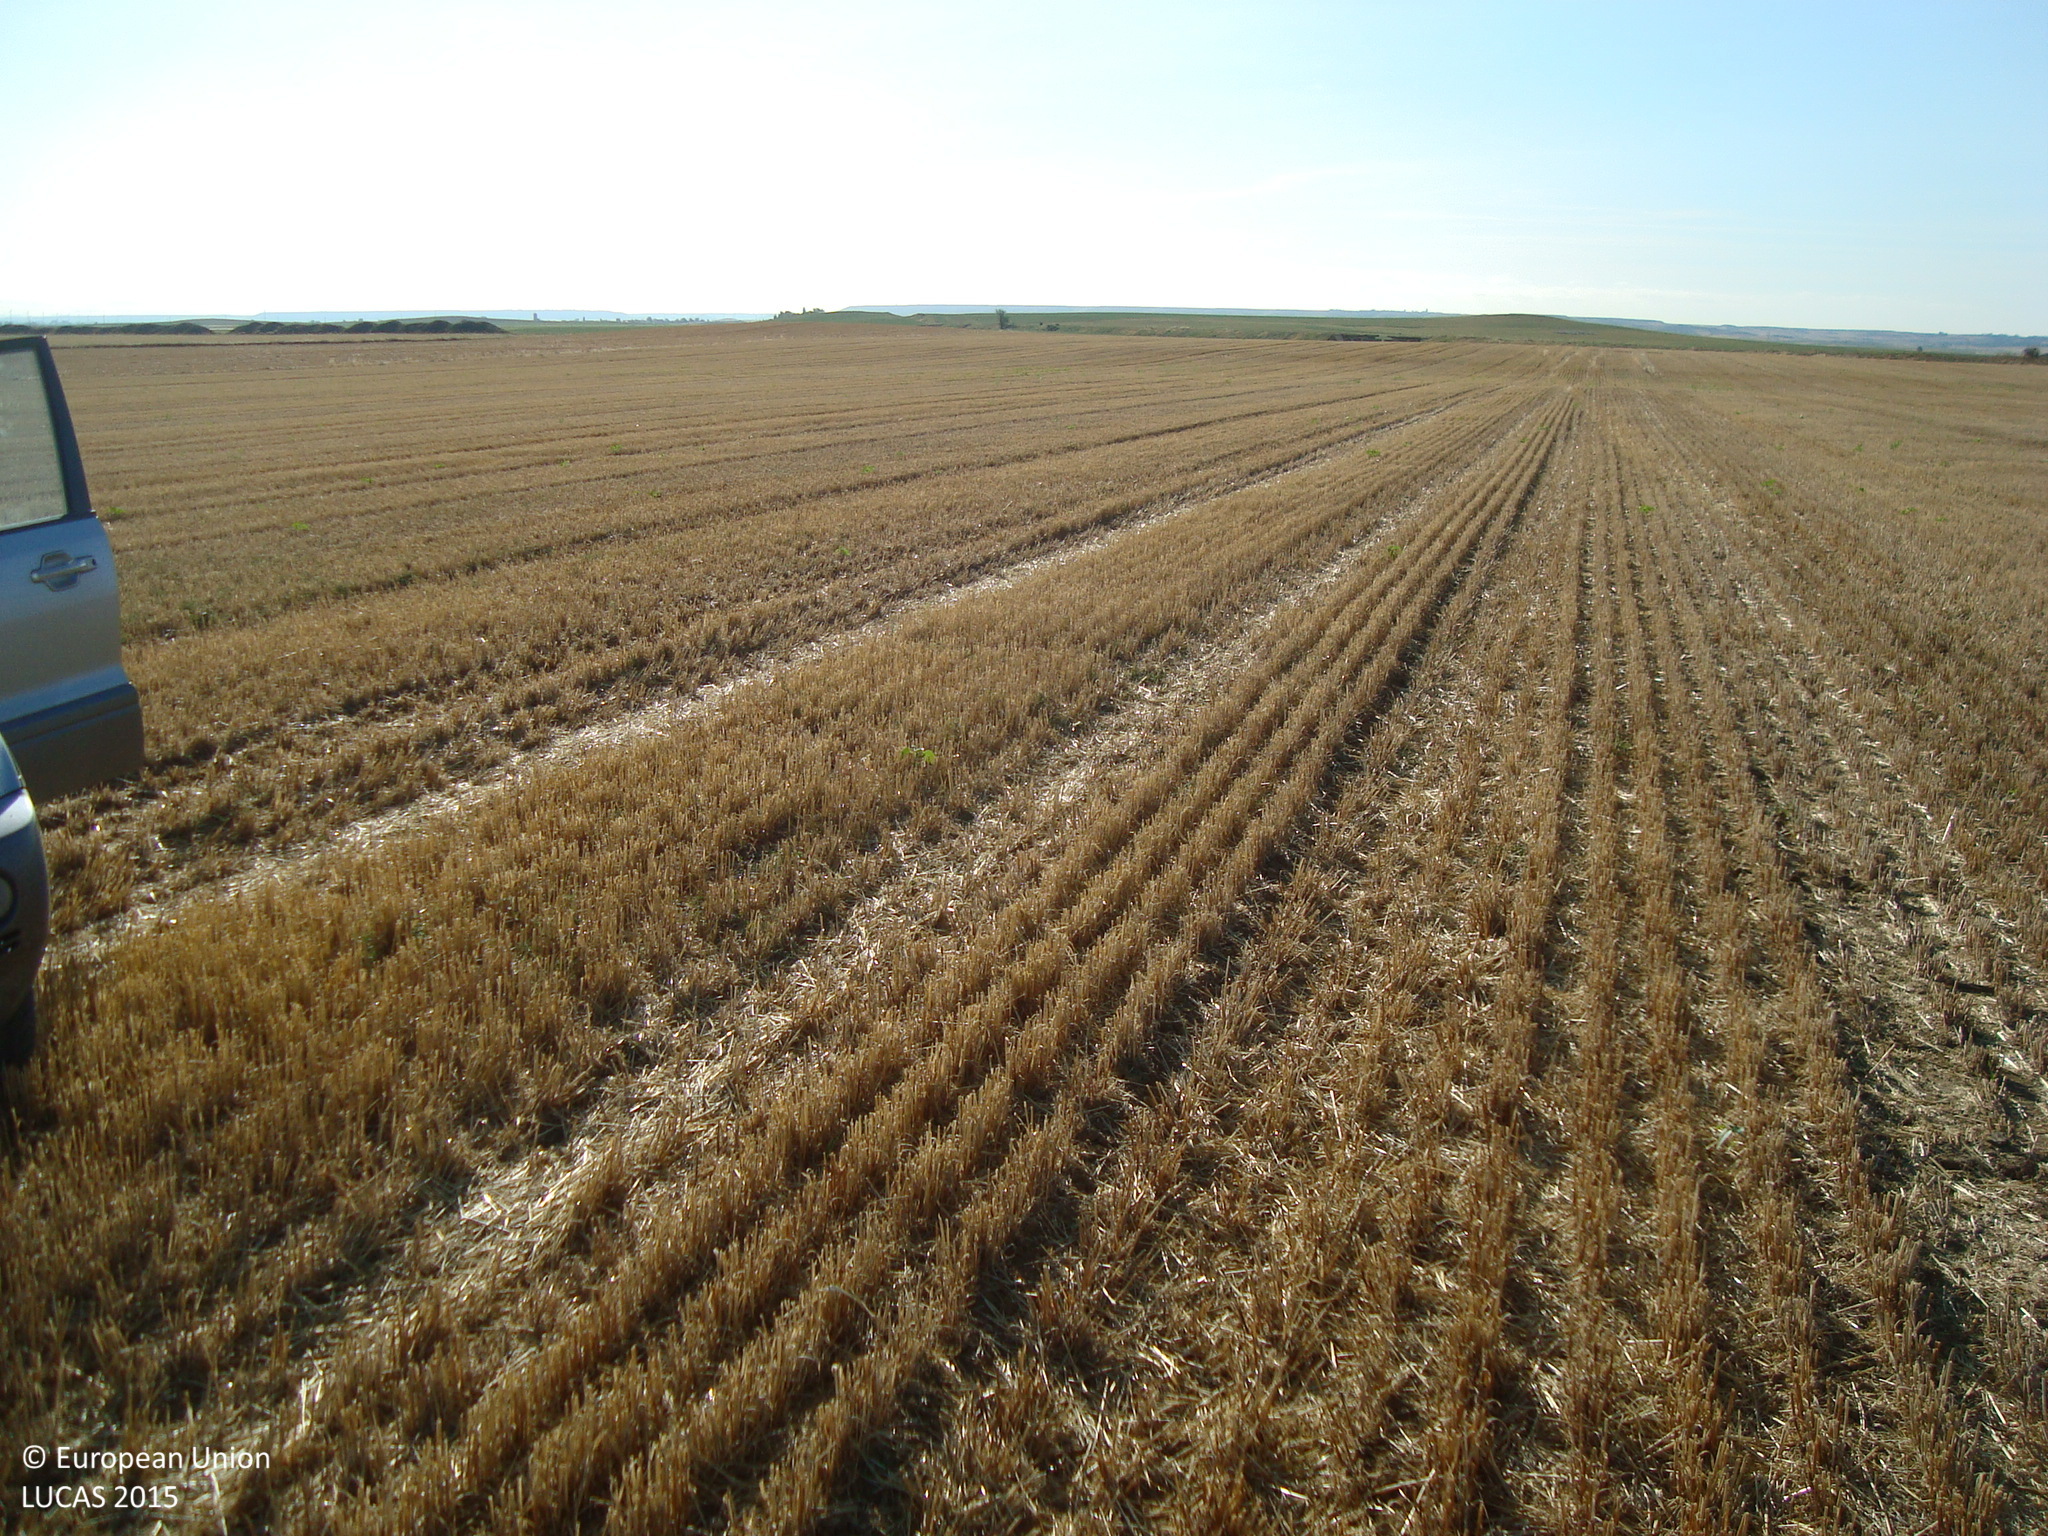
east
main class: Cropland
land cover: Barley
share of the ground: > 75 %
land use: Agriculture (excluding fallow land and kitchen gardens)
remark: Harvested field
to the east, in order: Barley
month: July
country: ES
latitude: 42.0222
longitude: -4.7723
